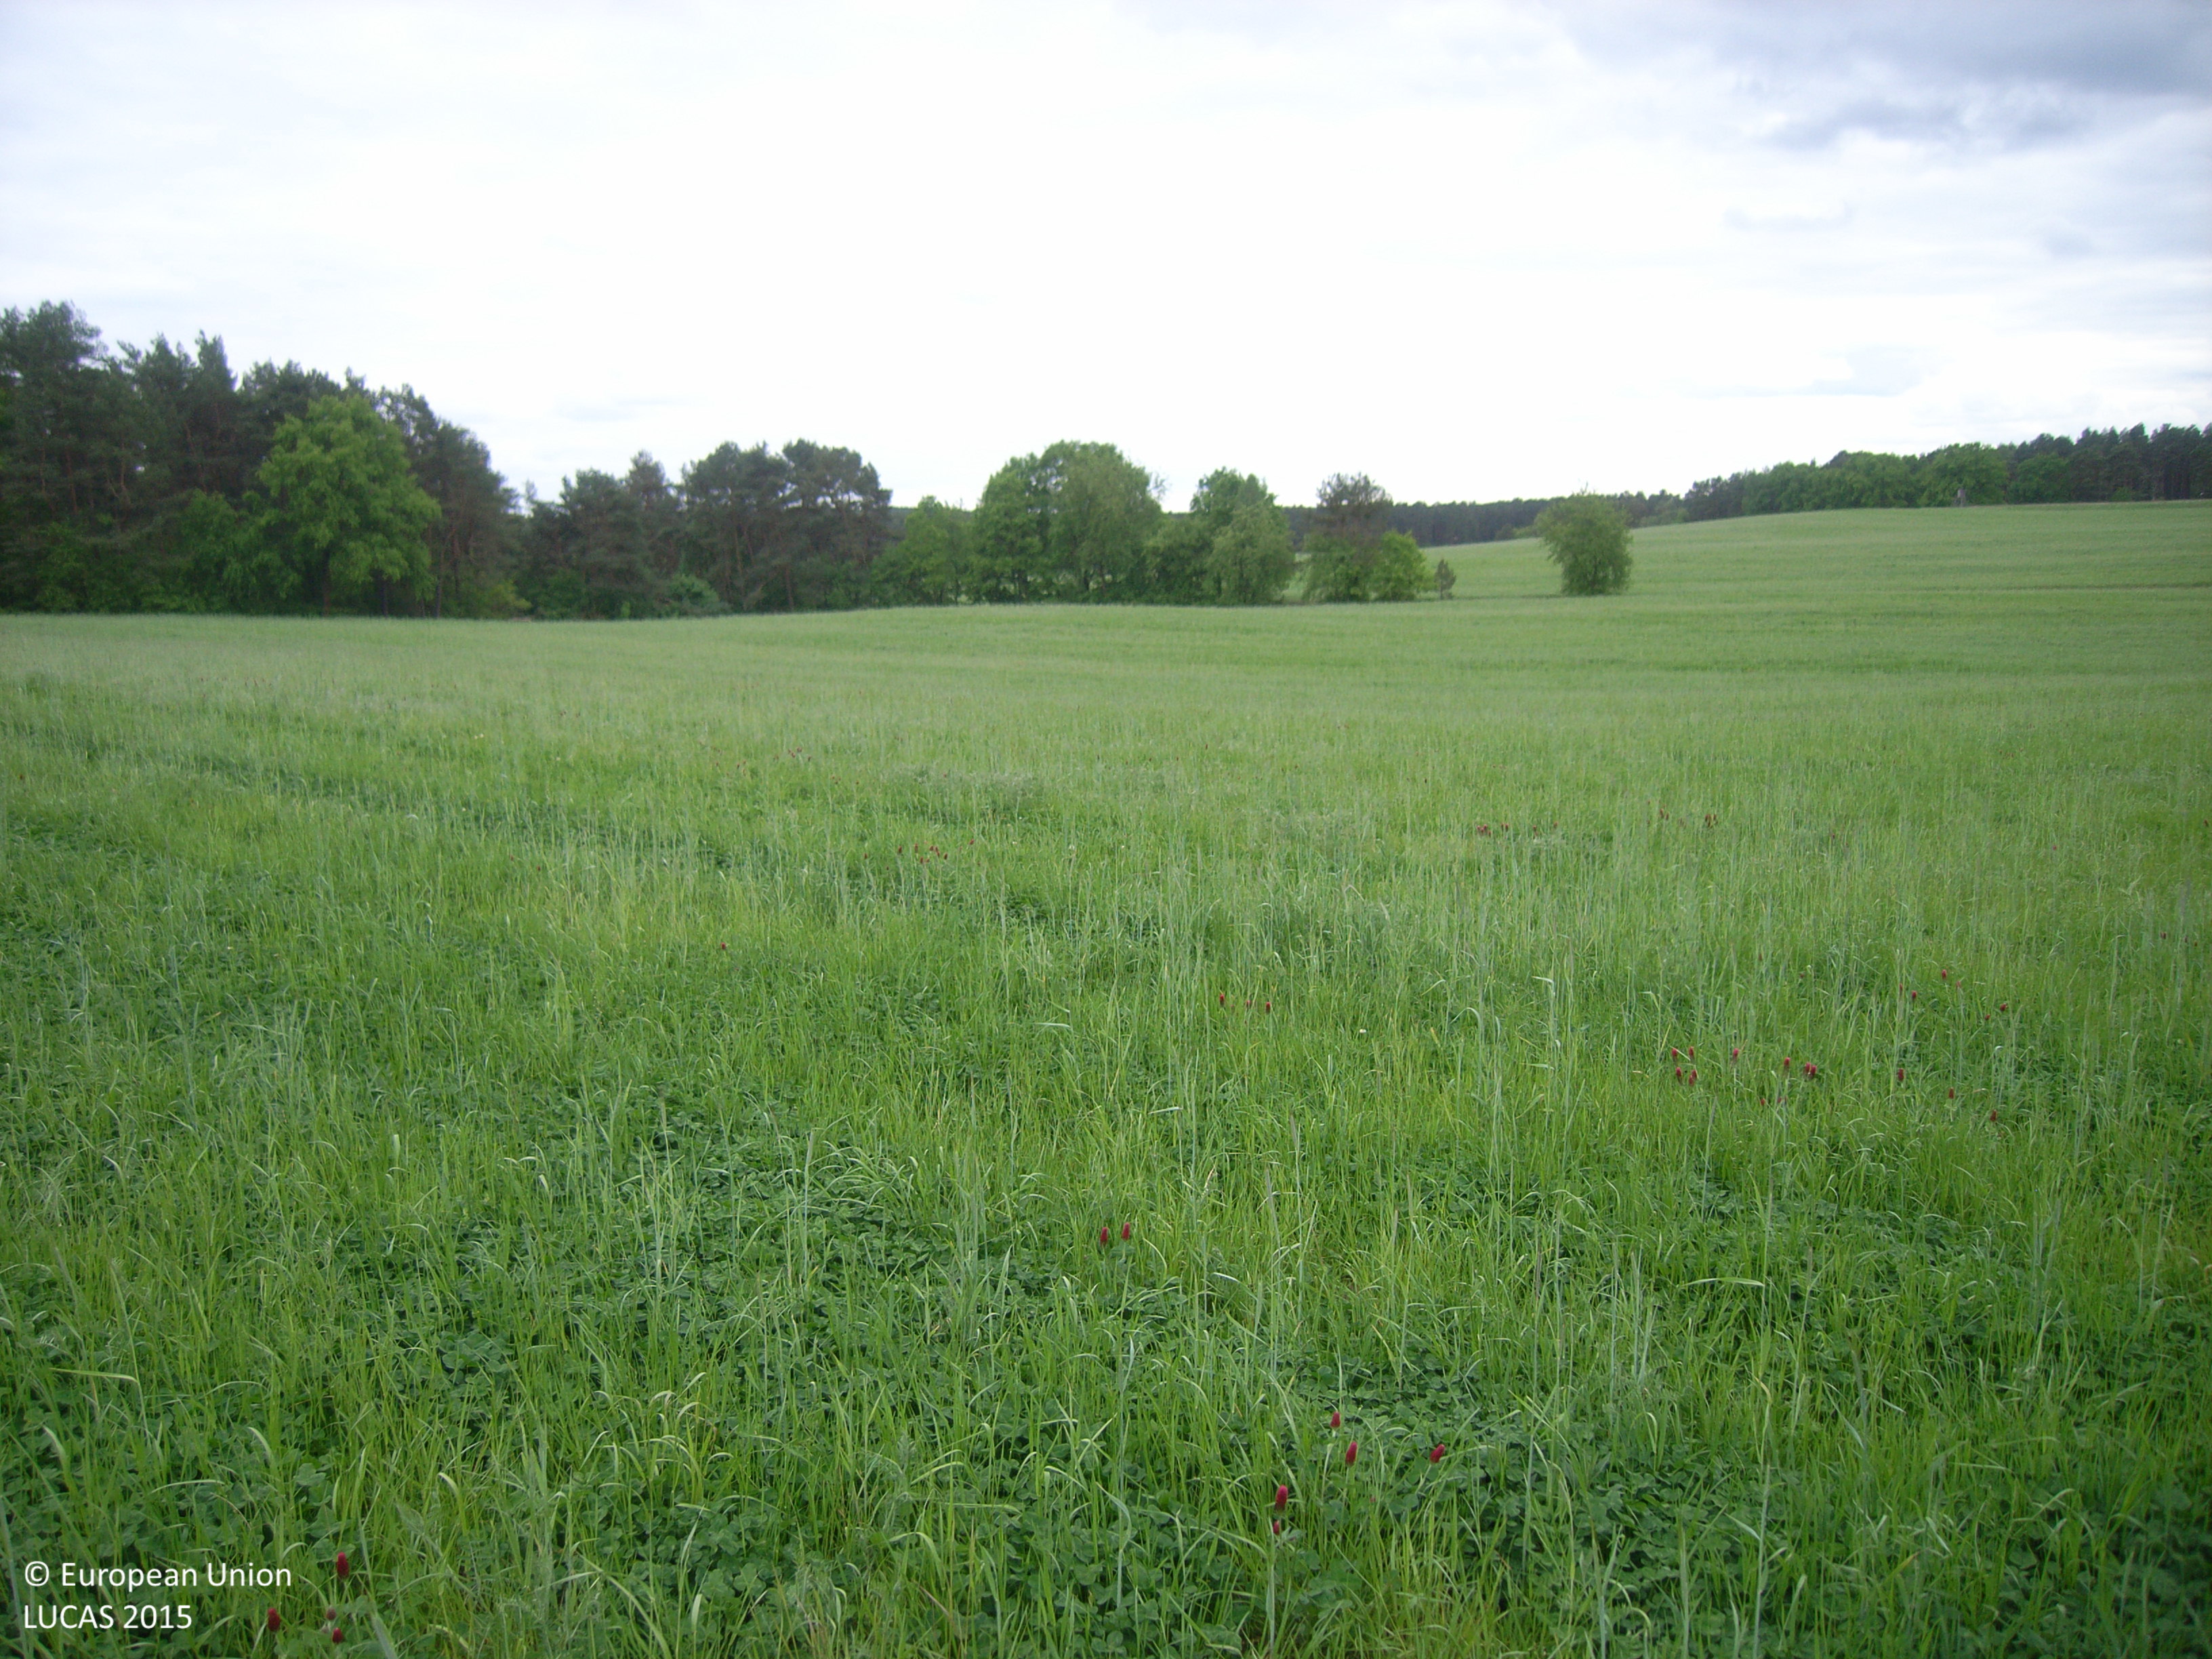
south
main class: Cropland
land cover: Other leguminous and mixtures for fodder
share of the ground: > 75 %
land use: Agriculture (excluding fallow land and kitchen gardens)
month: May
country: DE
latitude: 52.1436
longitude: 13.5805
